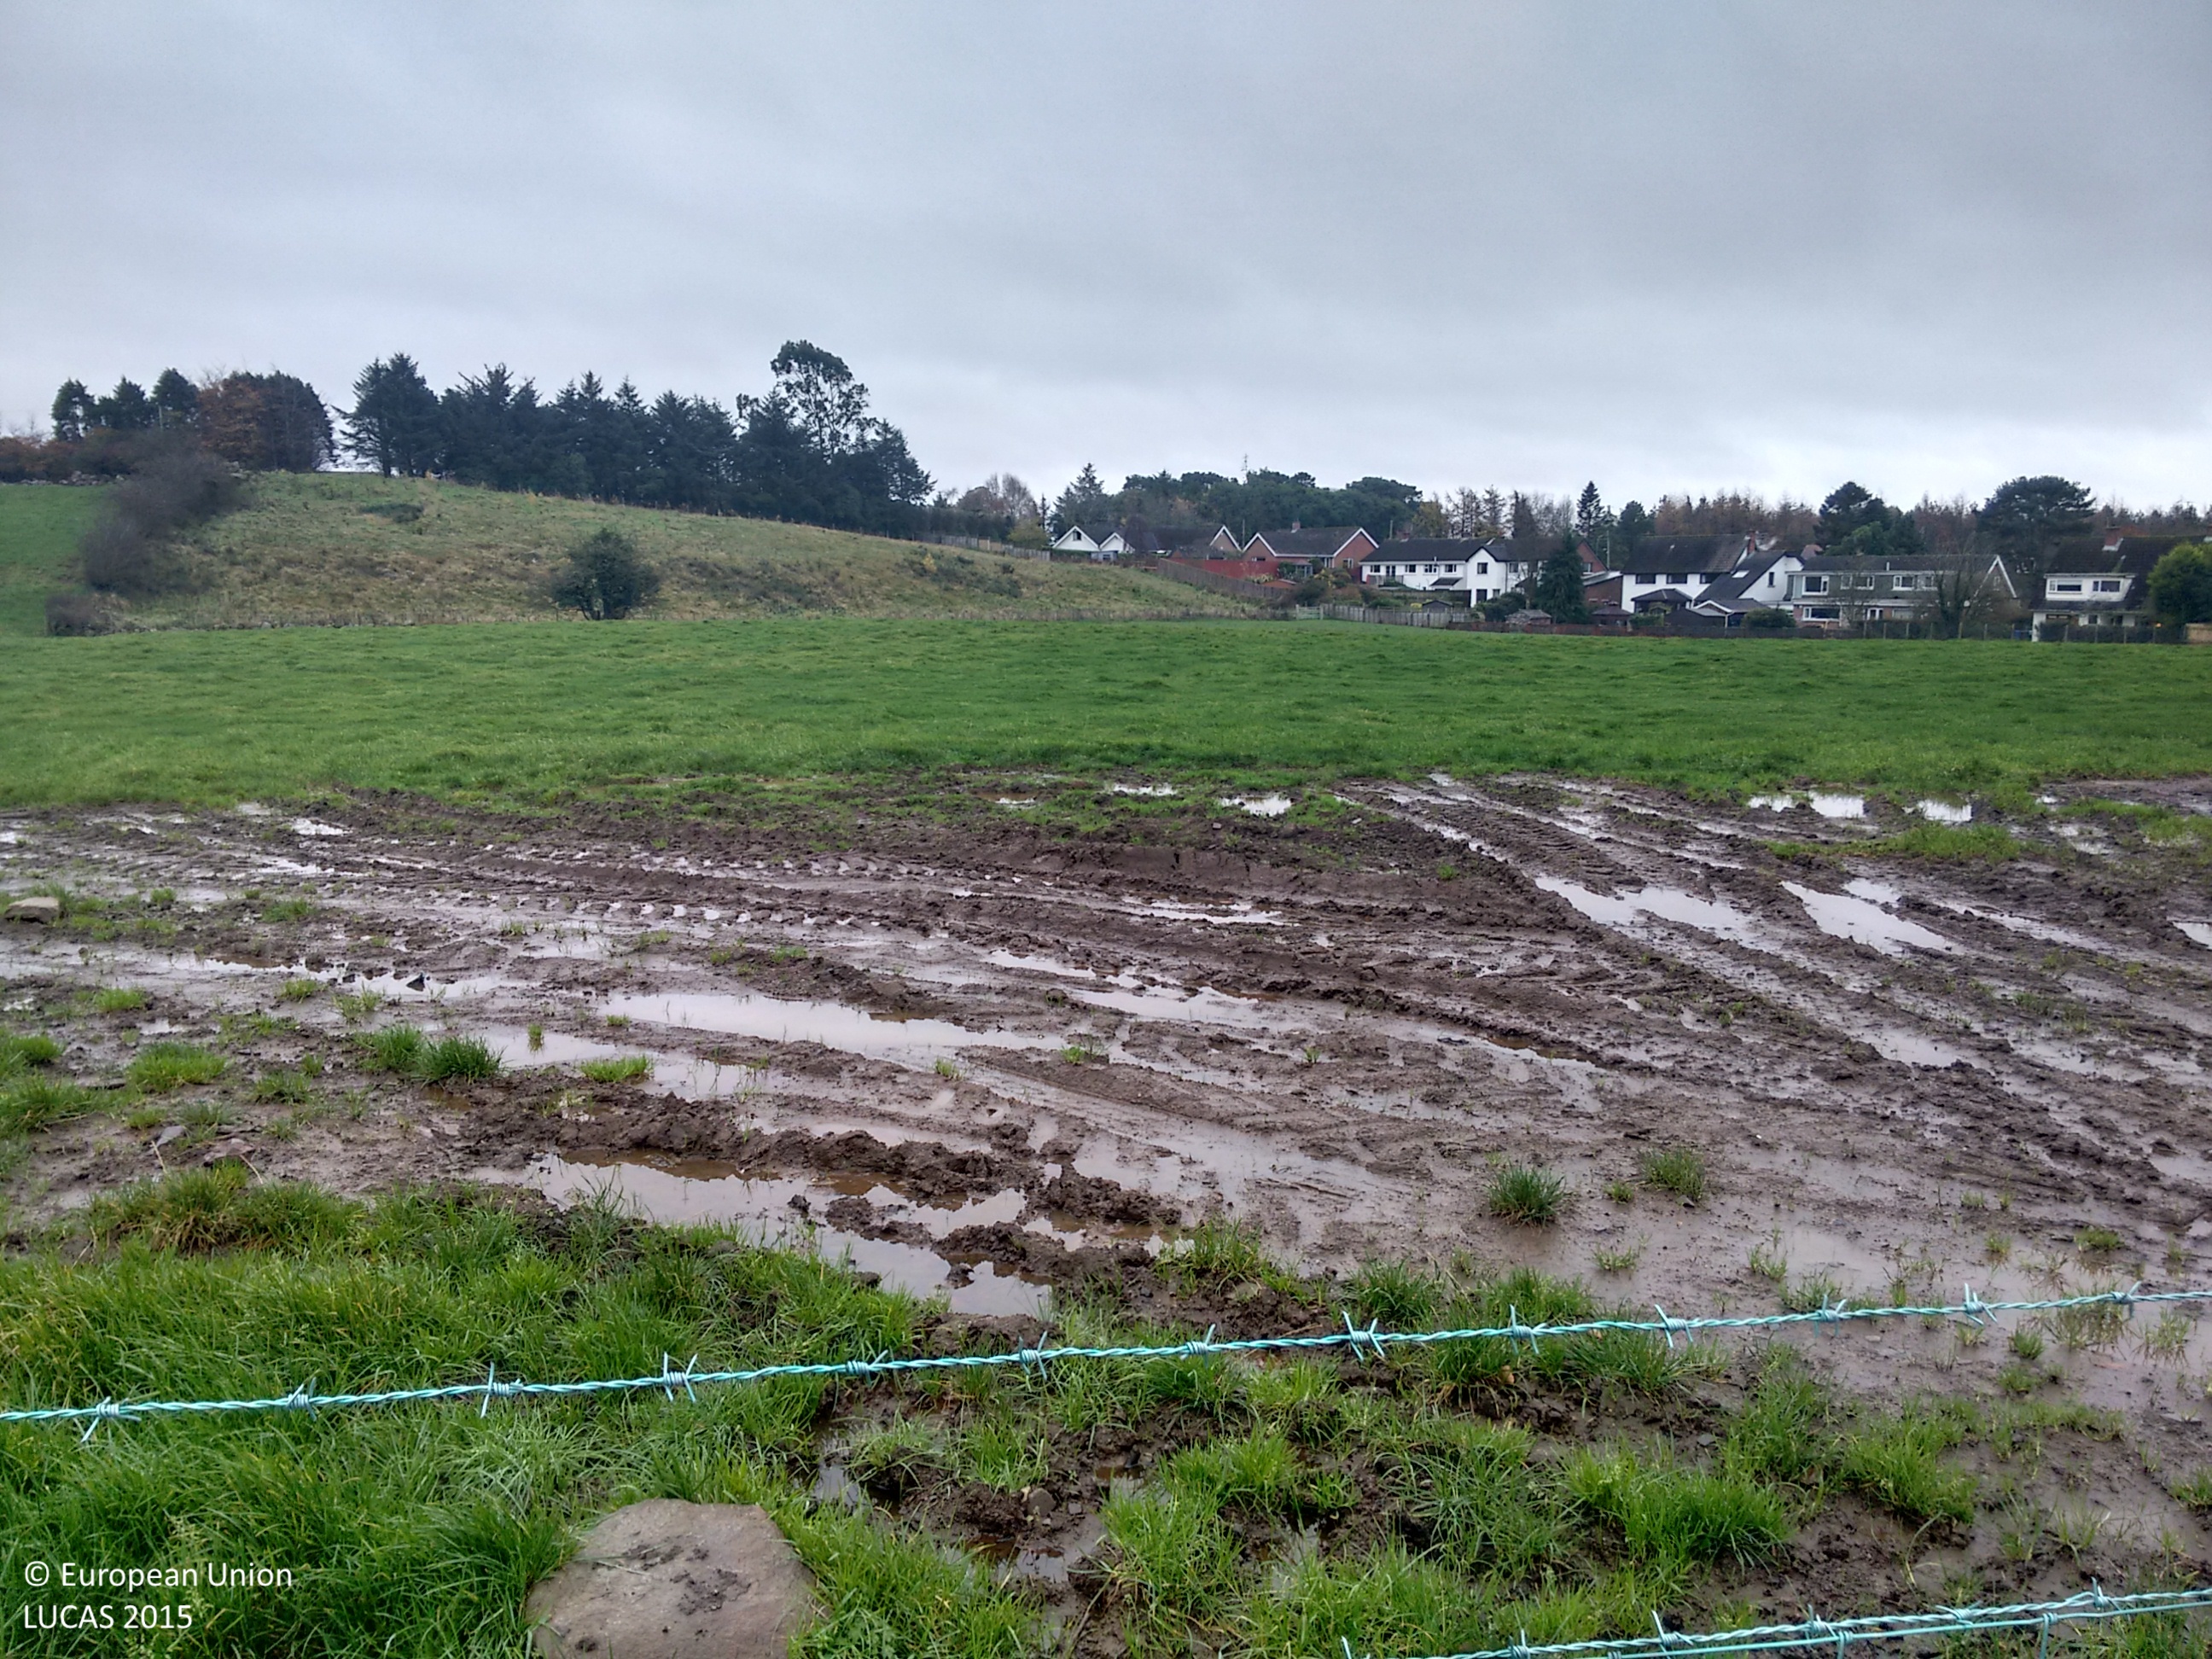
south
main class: Grassland
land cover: Grassland without tree/shrub cover
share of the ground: > 75 %
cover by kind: herbaceous plants 100 %
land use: Agriculture (excluding fallow land and kitchen gardens)
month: November
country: GB
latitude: 54.5998
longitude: -5.7523
